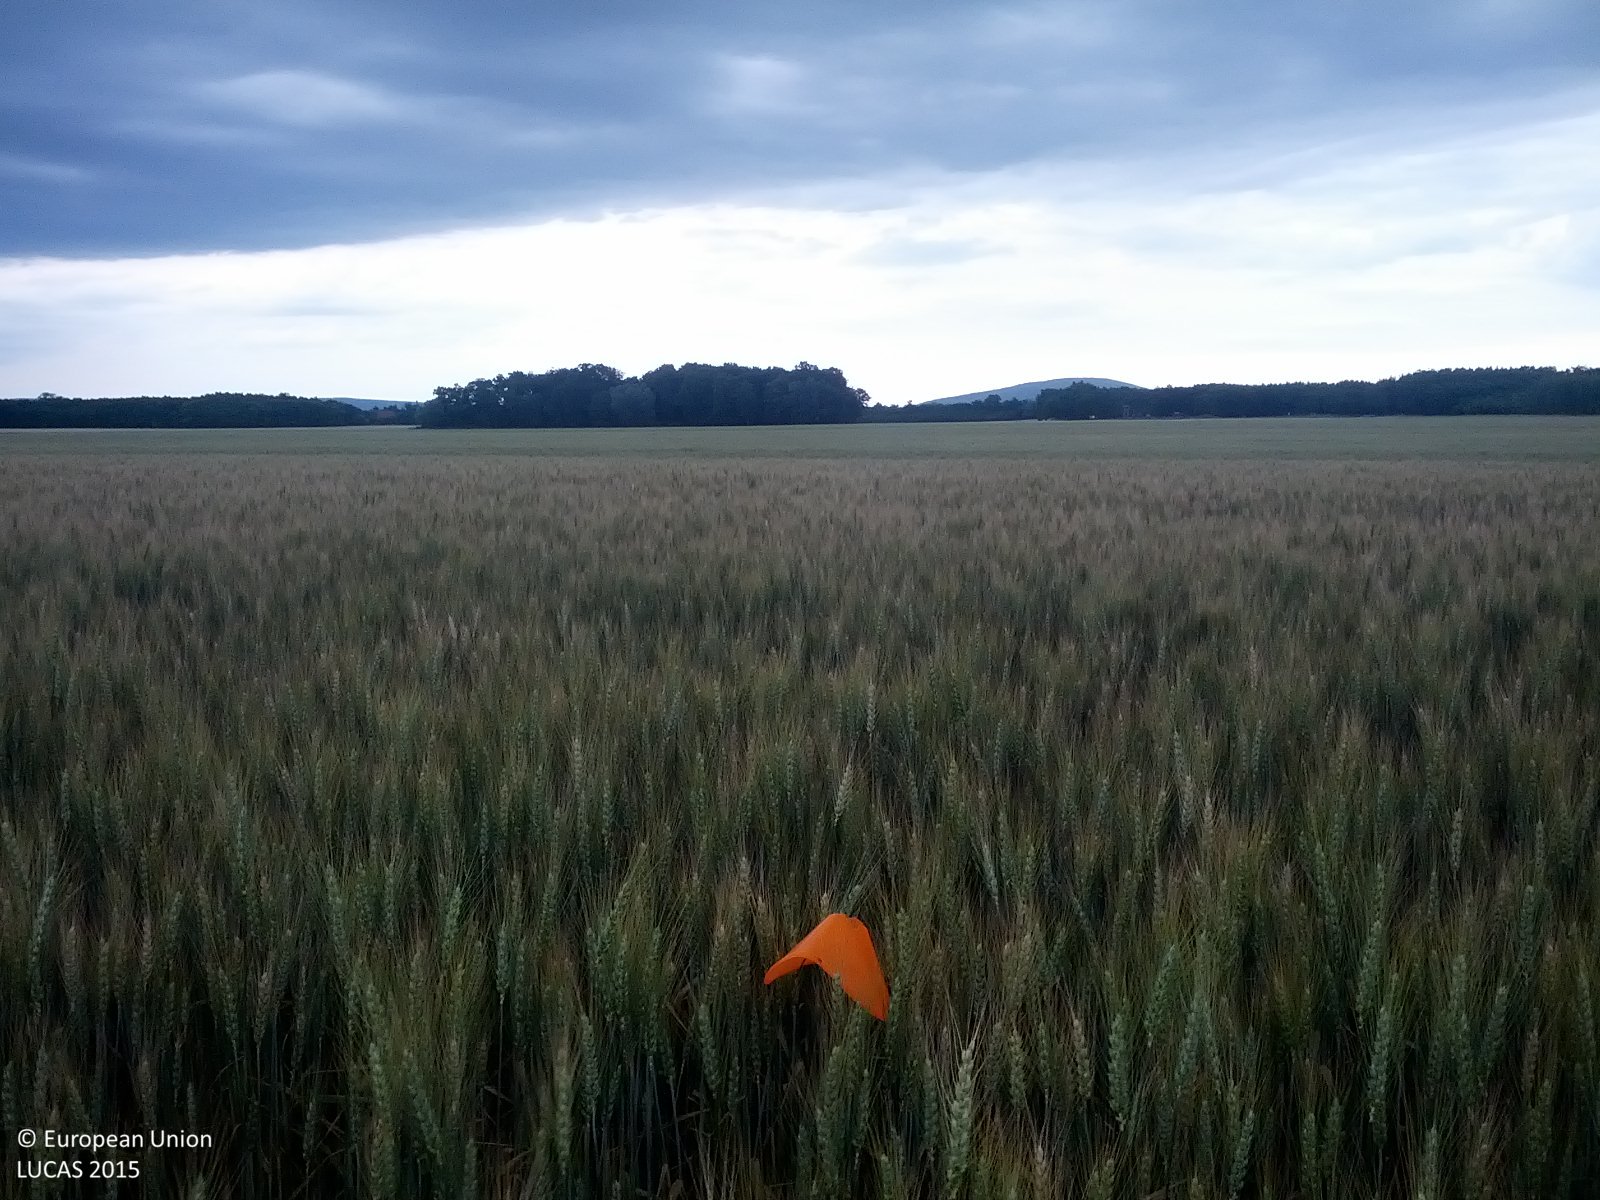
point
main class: Cropland
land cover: Common wheat
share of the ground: > 75 %
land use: Agriculture (excluding fallow land and kitchen gardens)
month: June
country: AT
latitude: 48.2803
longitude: 16.8662
